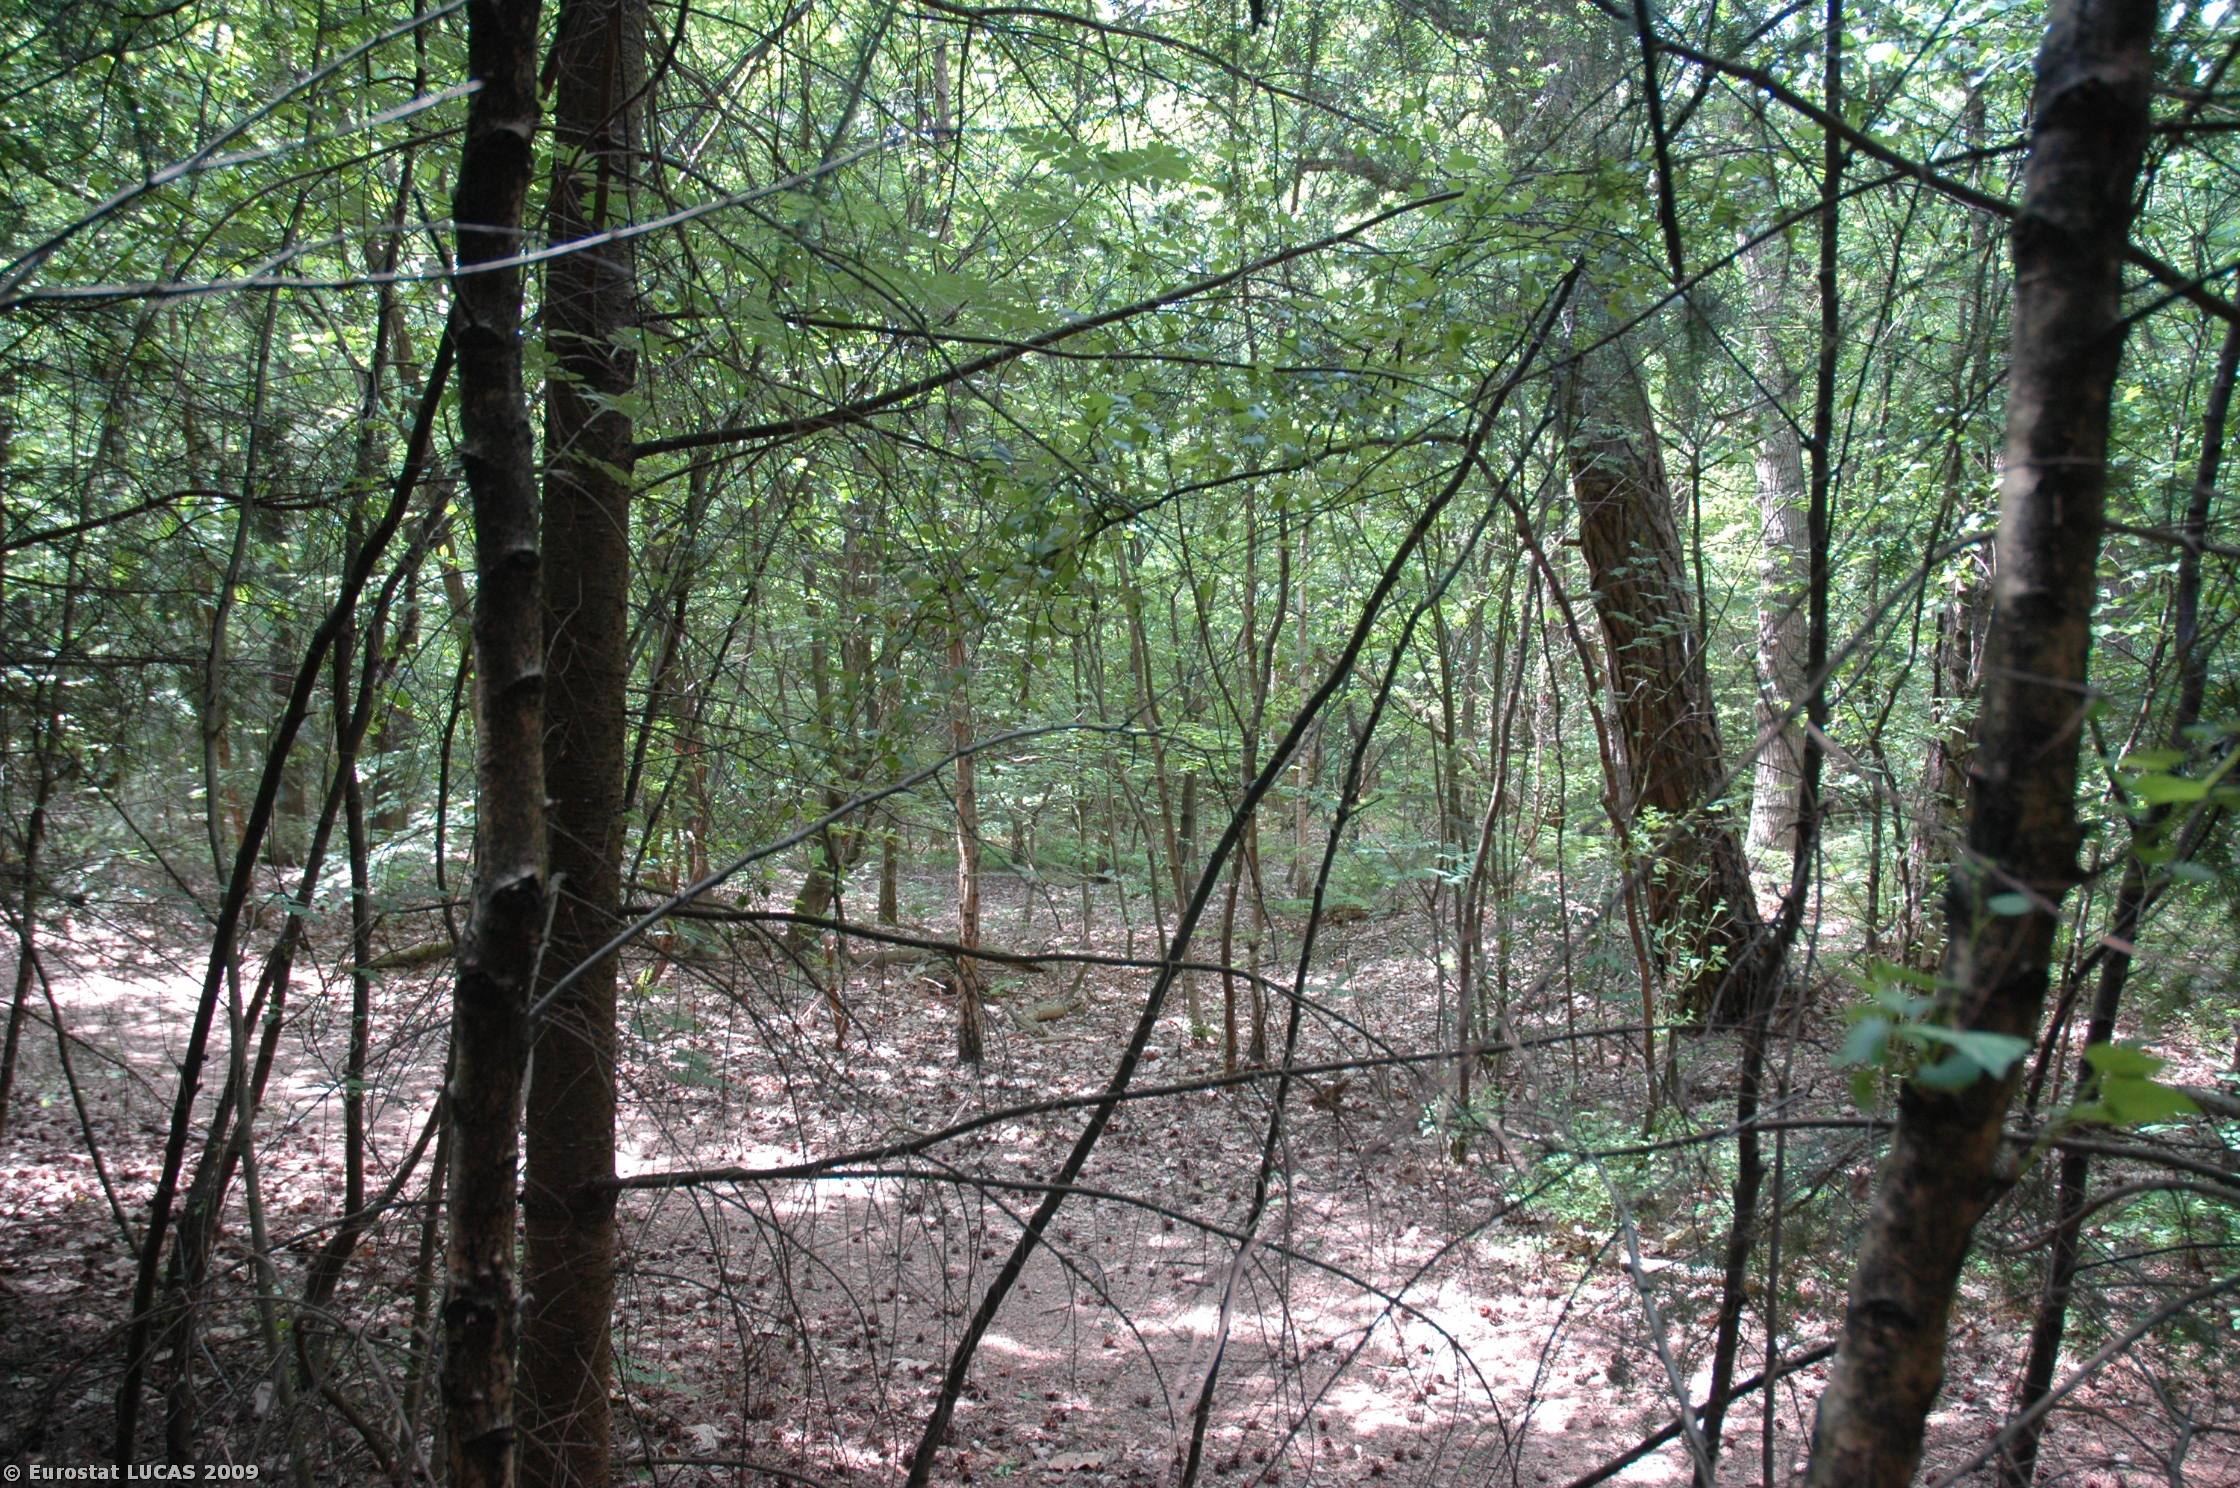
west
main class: Woodland
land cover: Mixed woodland
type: hemiboreal forest and nemoral coniferous forest and mixed broadleaved-coniferous forest
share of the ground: > 75 %
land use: Amenities, museums, leisure
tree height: > 5 m
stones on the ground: < 10 %
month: May
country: NL
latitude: 52.0881
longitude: 5.3423
